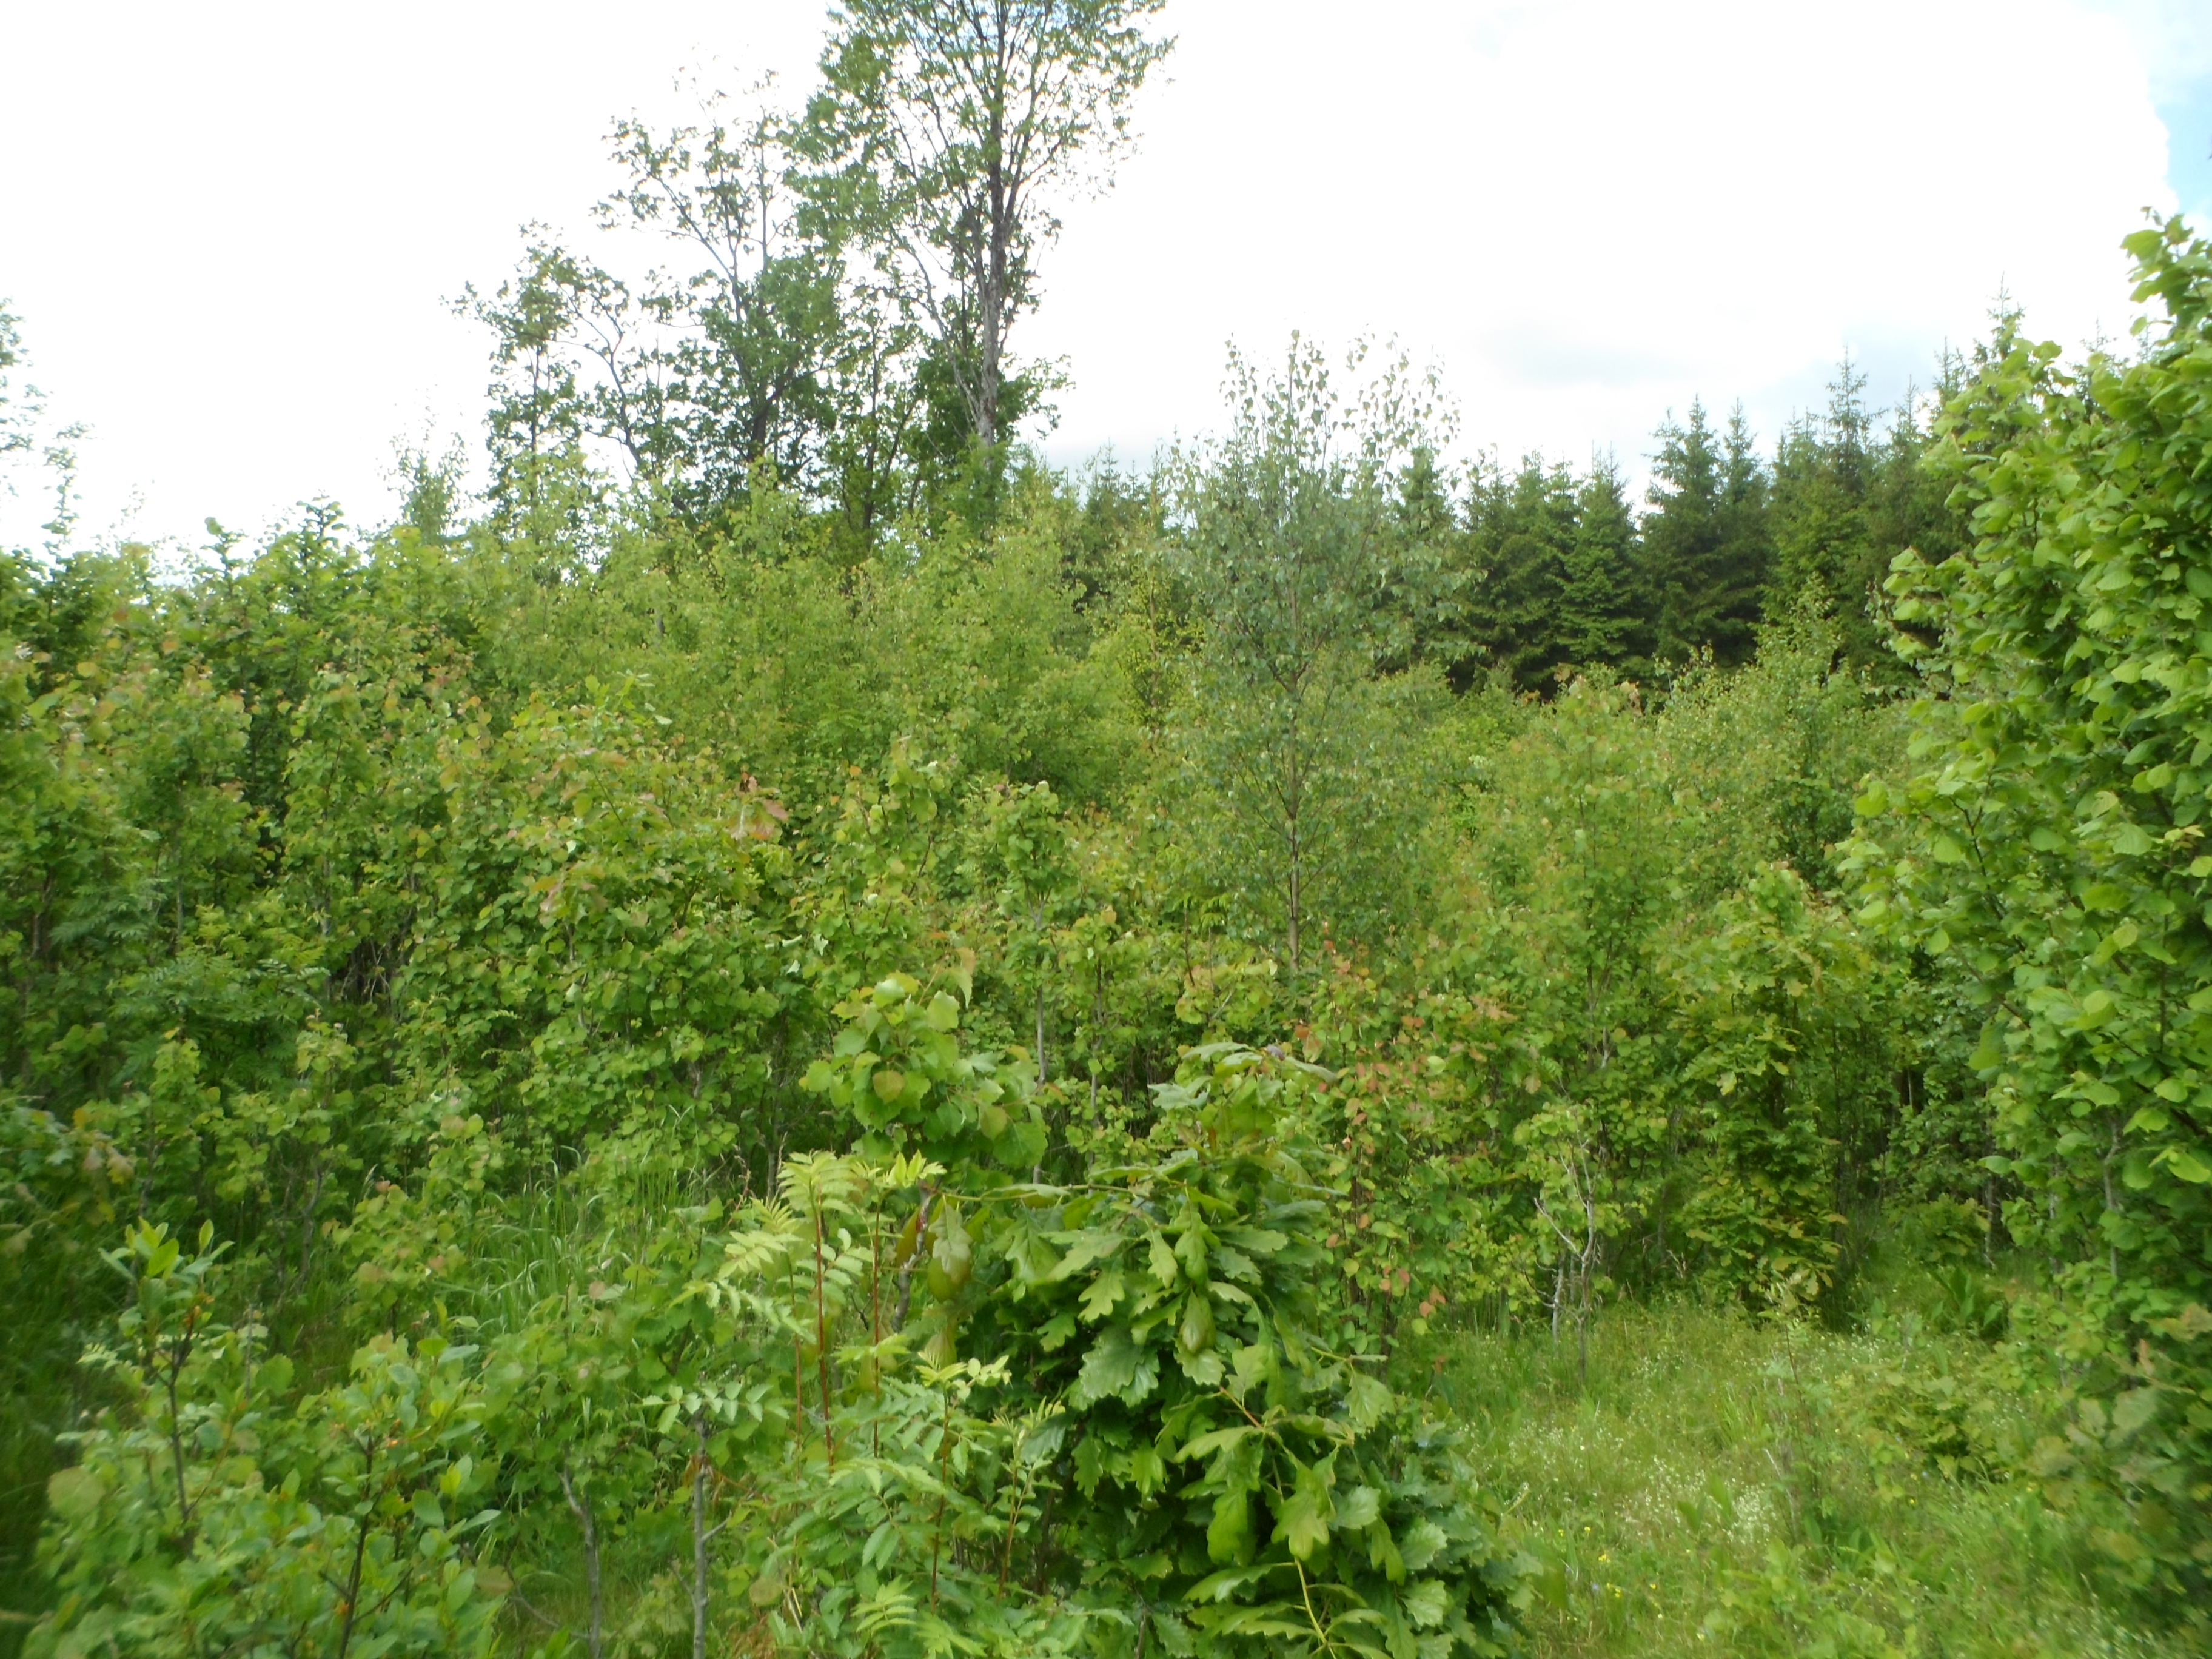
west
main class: Woodland
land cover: Broadleaved woodland
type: boreal forest
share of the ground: 50 - 75 %
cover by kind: broadleaved forest trees 65 %, herbaceous plants 30 %, coniferous forest trees 5 %
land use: Forestry
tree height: < 5 m
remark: Clear cut
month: June
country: SE
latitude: 56.9445
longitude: 14.2869
